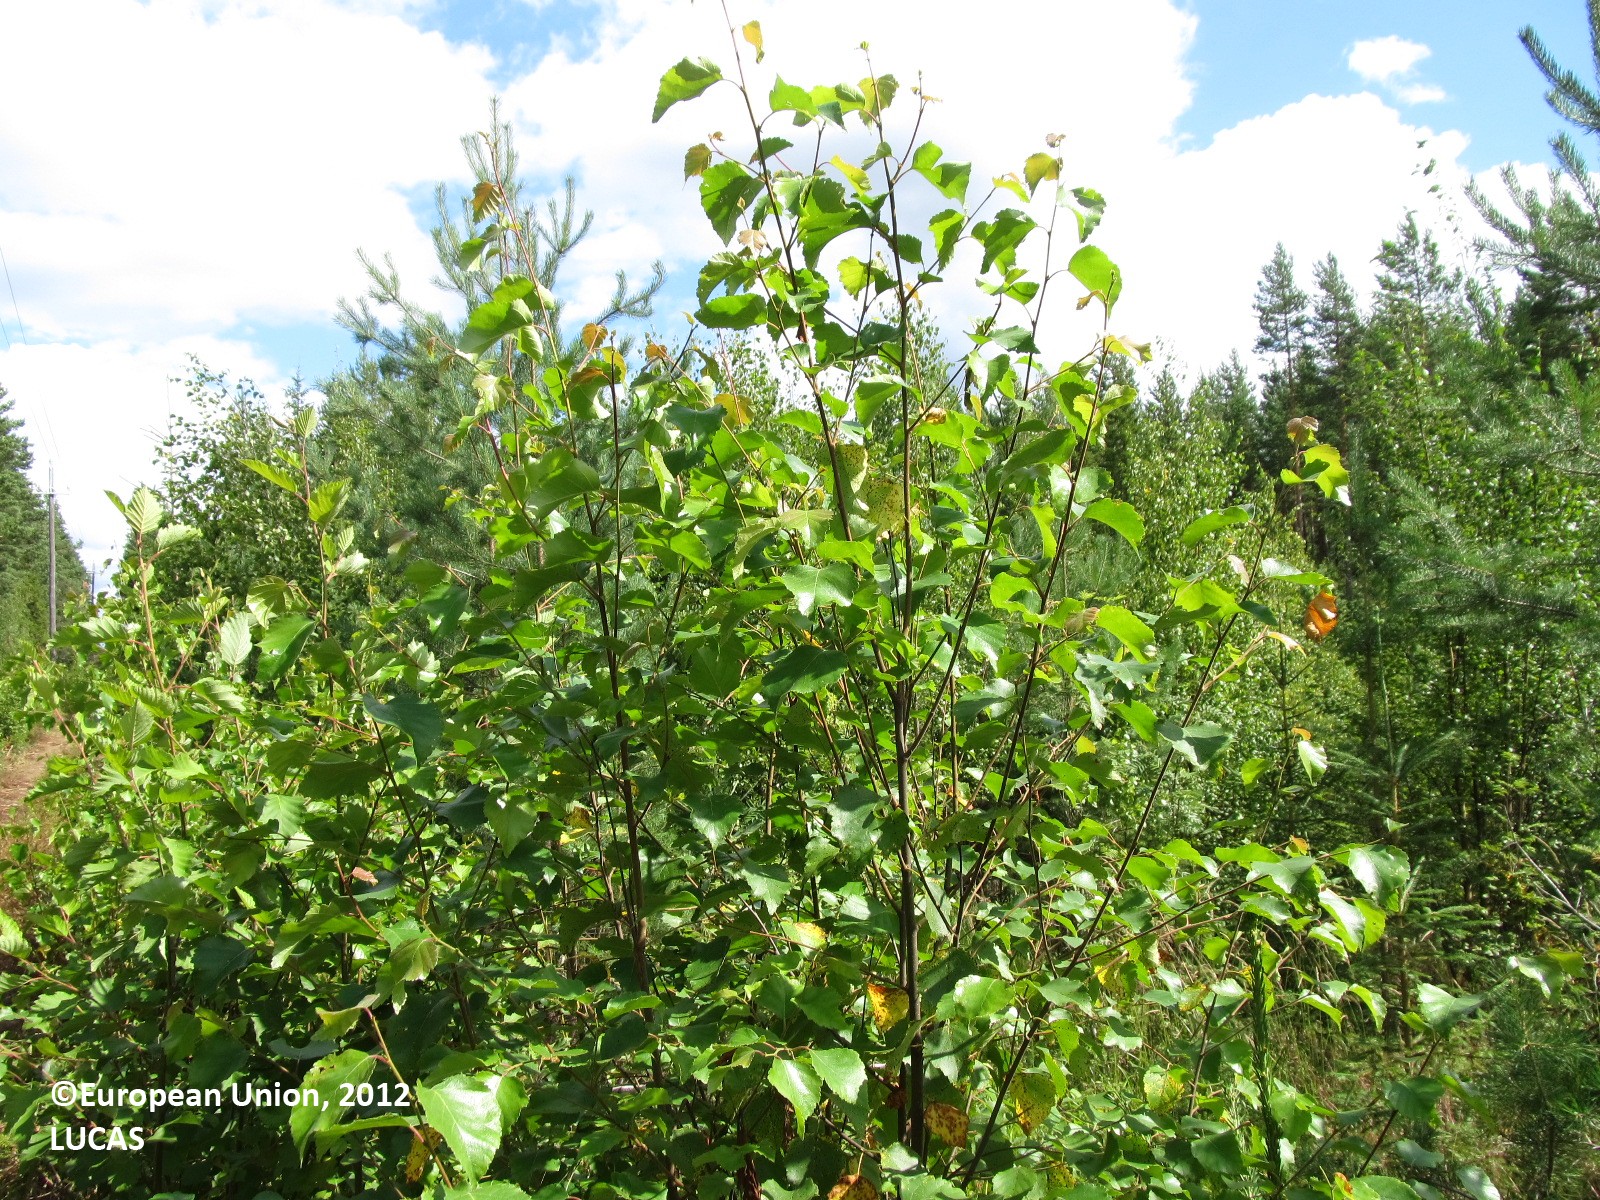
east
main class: Woodland
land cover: Pine dominated mixed woodland
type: boreal forest
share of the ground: 50 - 75 %
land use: Forestry
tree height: < 5 m
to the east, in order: Pine dominated mixed woodland; Tracks; Pine dominated mixed woodland; Tracks; Spruce dominated coniferous woodland; Pine dominated coniferous woodland
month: August
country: FI
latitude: 61.6874
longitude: 27.9378
